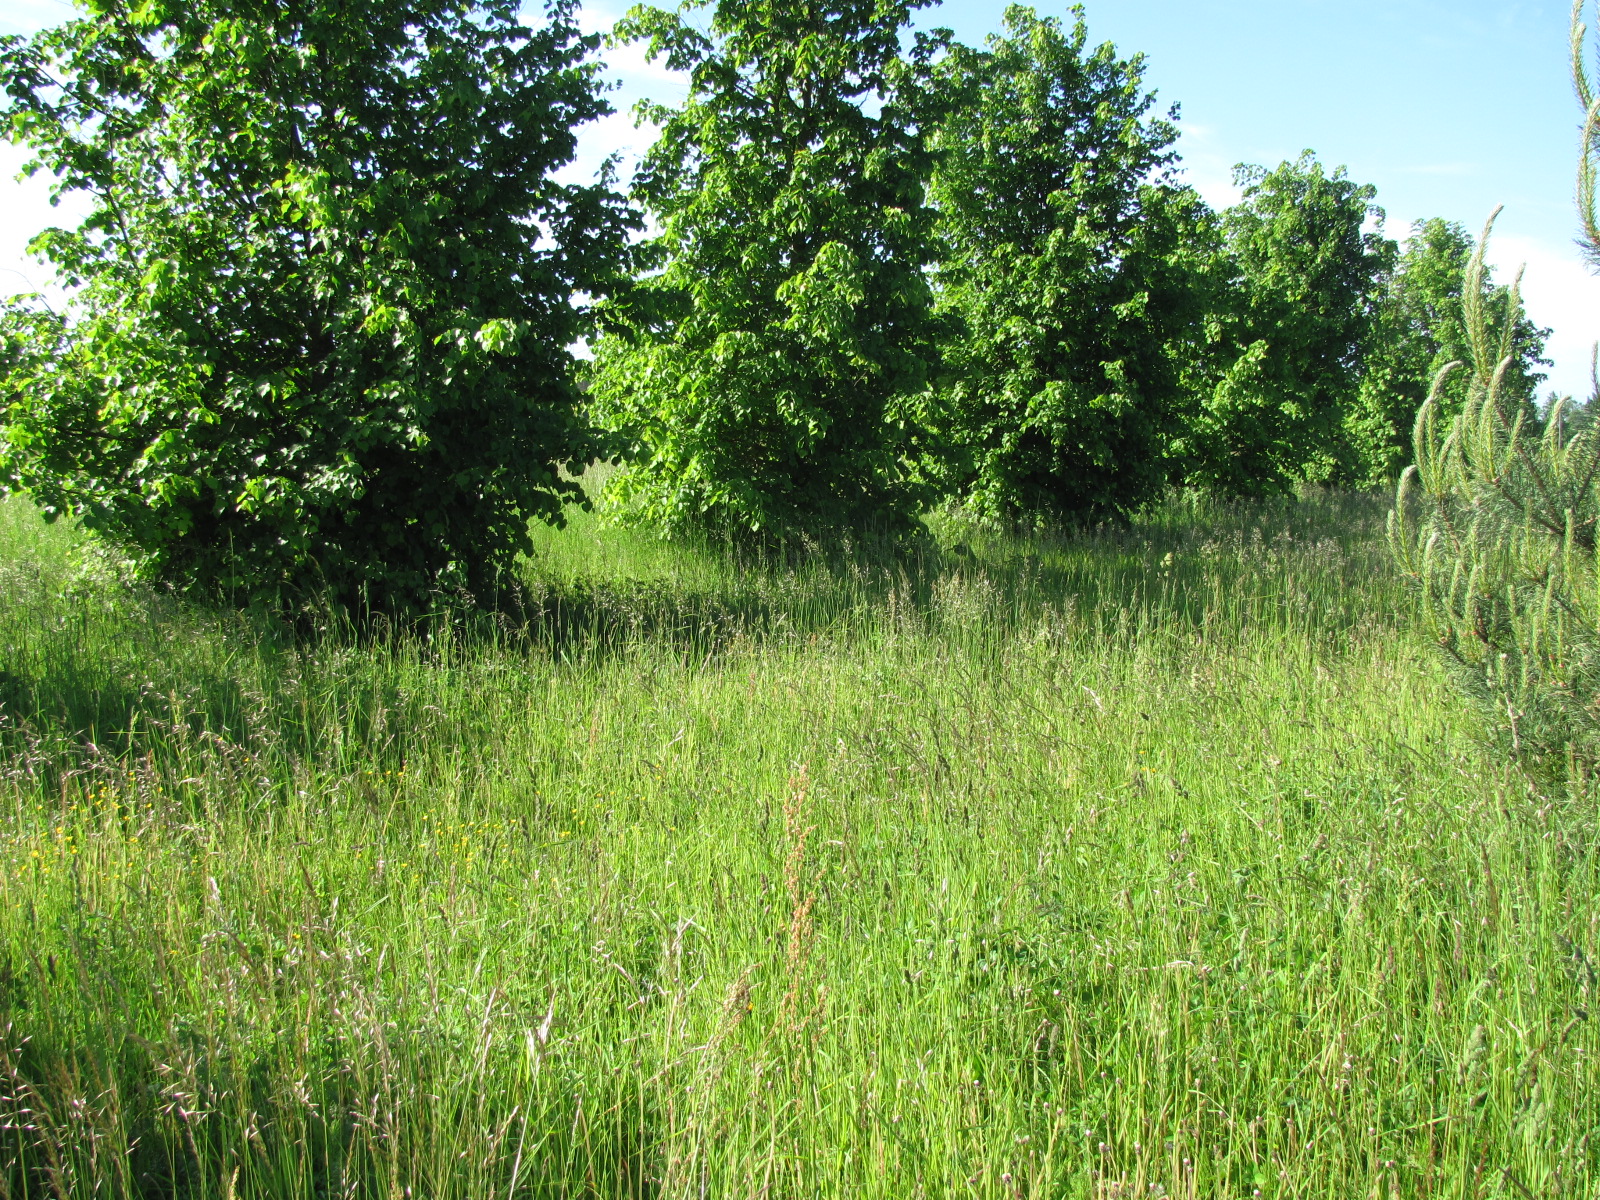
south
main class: Grassland
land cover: Grassland without tree/shrub cover
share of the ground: > 75 %
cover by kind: herbaceous plants 100 %
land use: Residential
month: June
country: LV
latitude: 56.8516
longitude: 24.2396
